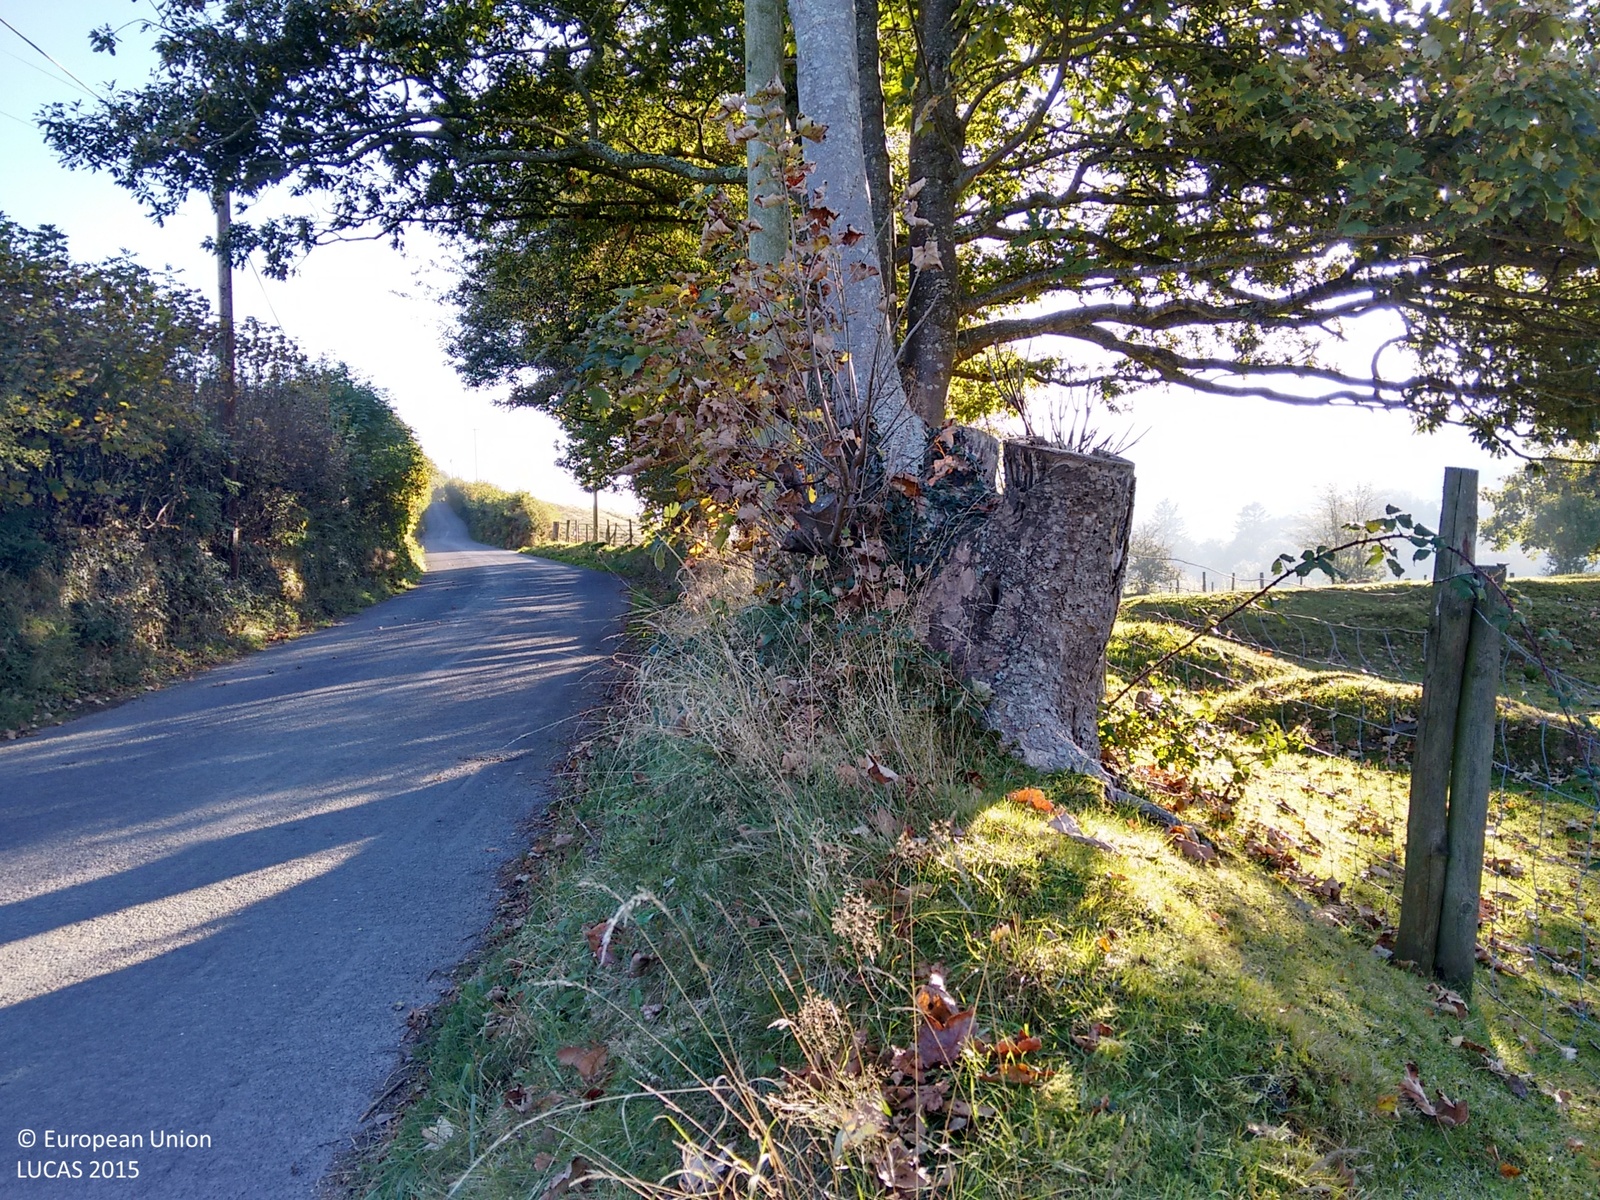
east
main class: Grassland
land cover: Grassland without tree/shrub cover
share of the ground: > 75 %
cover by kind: herbaceous plants 100 %
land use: Agriculture (excluding fallow land and kitchen gardens)
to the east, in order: Grassland without tree/shrub cover; Fences; Grassland without tree/shrub cover; Electric lines; Grassland without tree/shrub cover; Fences; Abandoned hedges; Grassland without tree/shrub cover
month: October
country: GB
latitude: 52.3531
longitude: -3.9382
